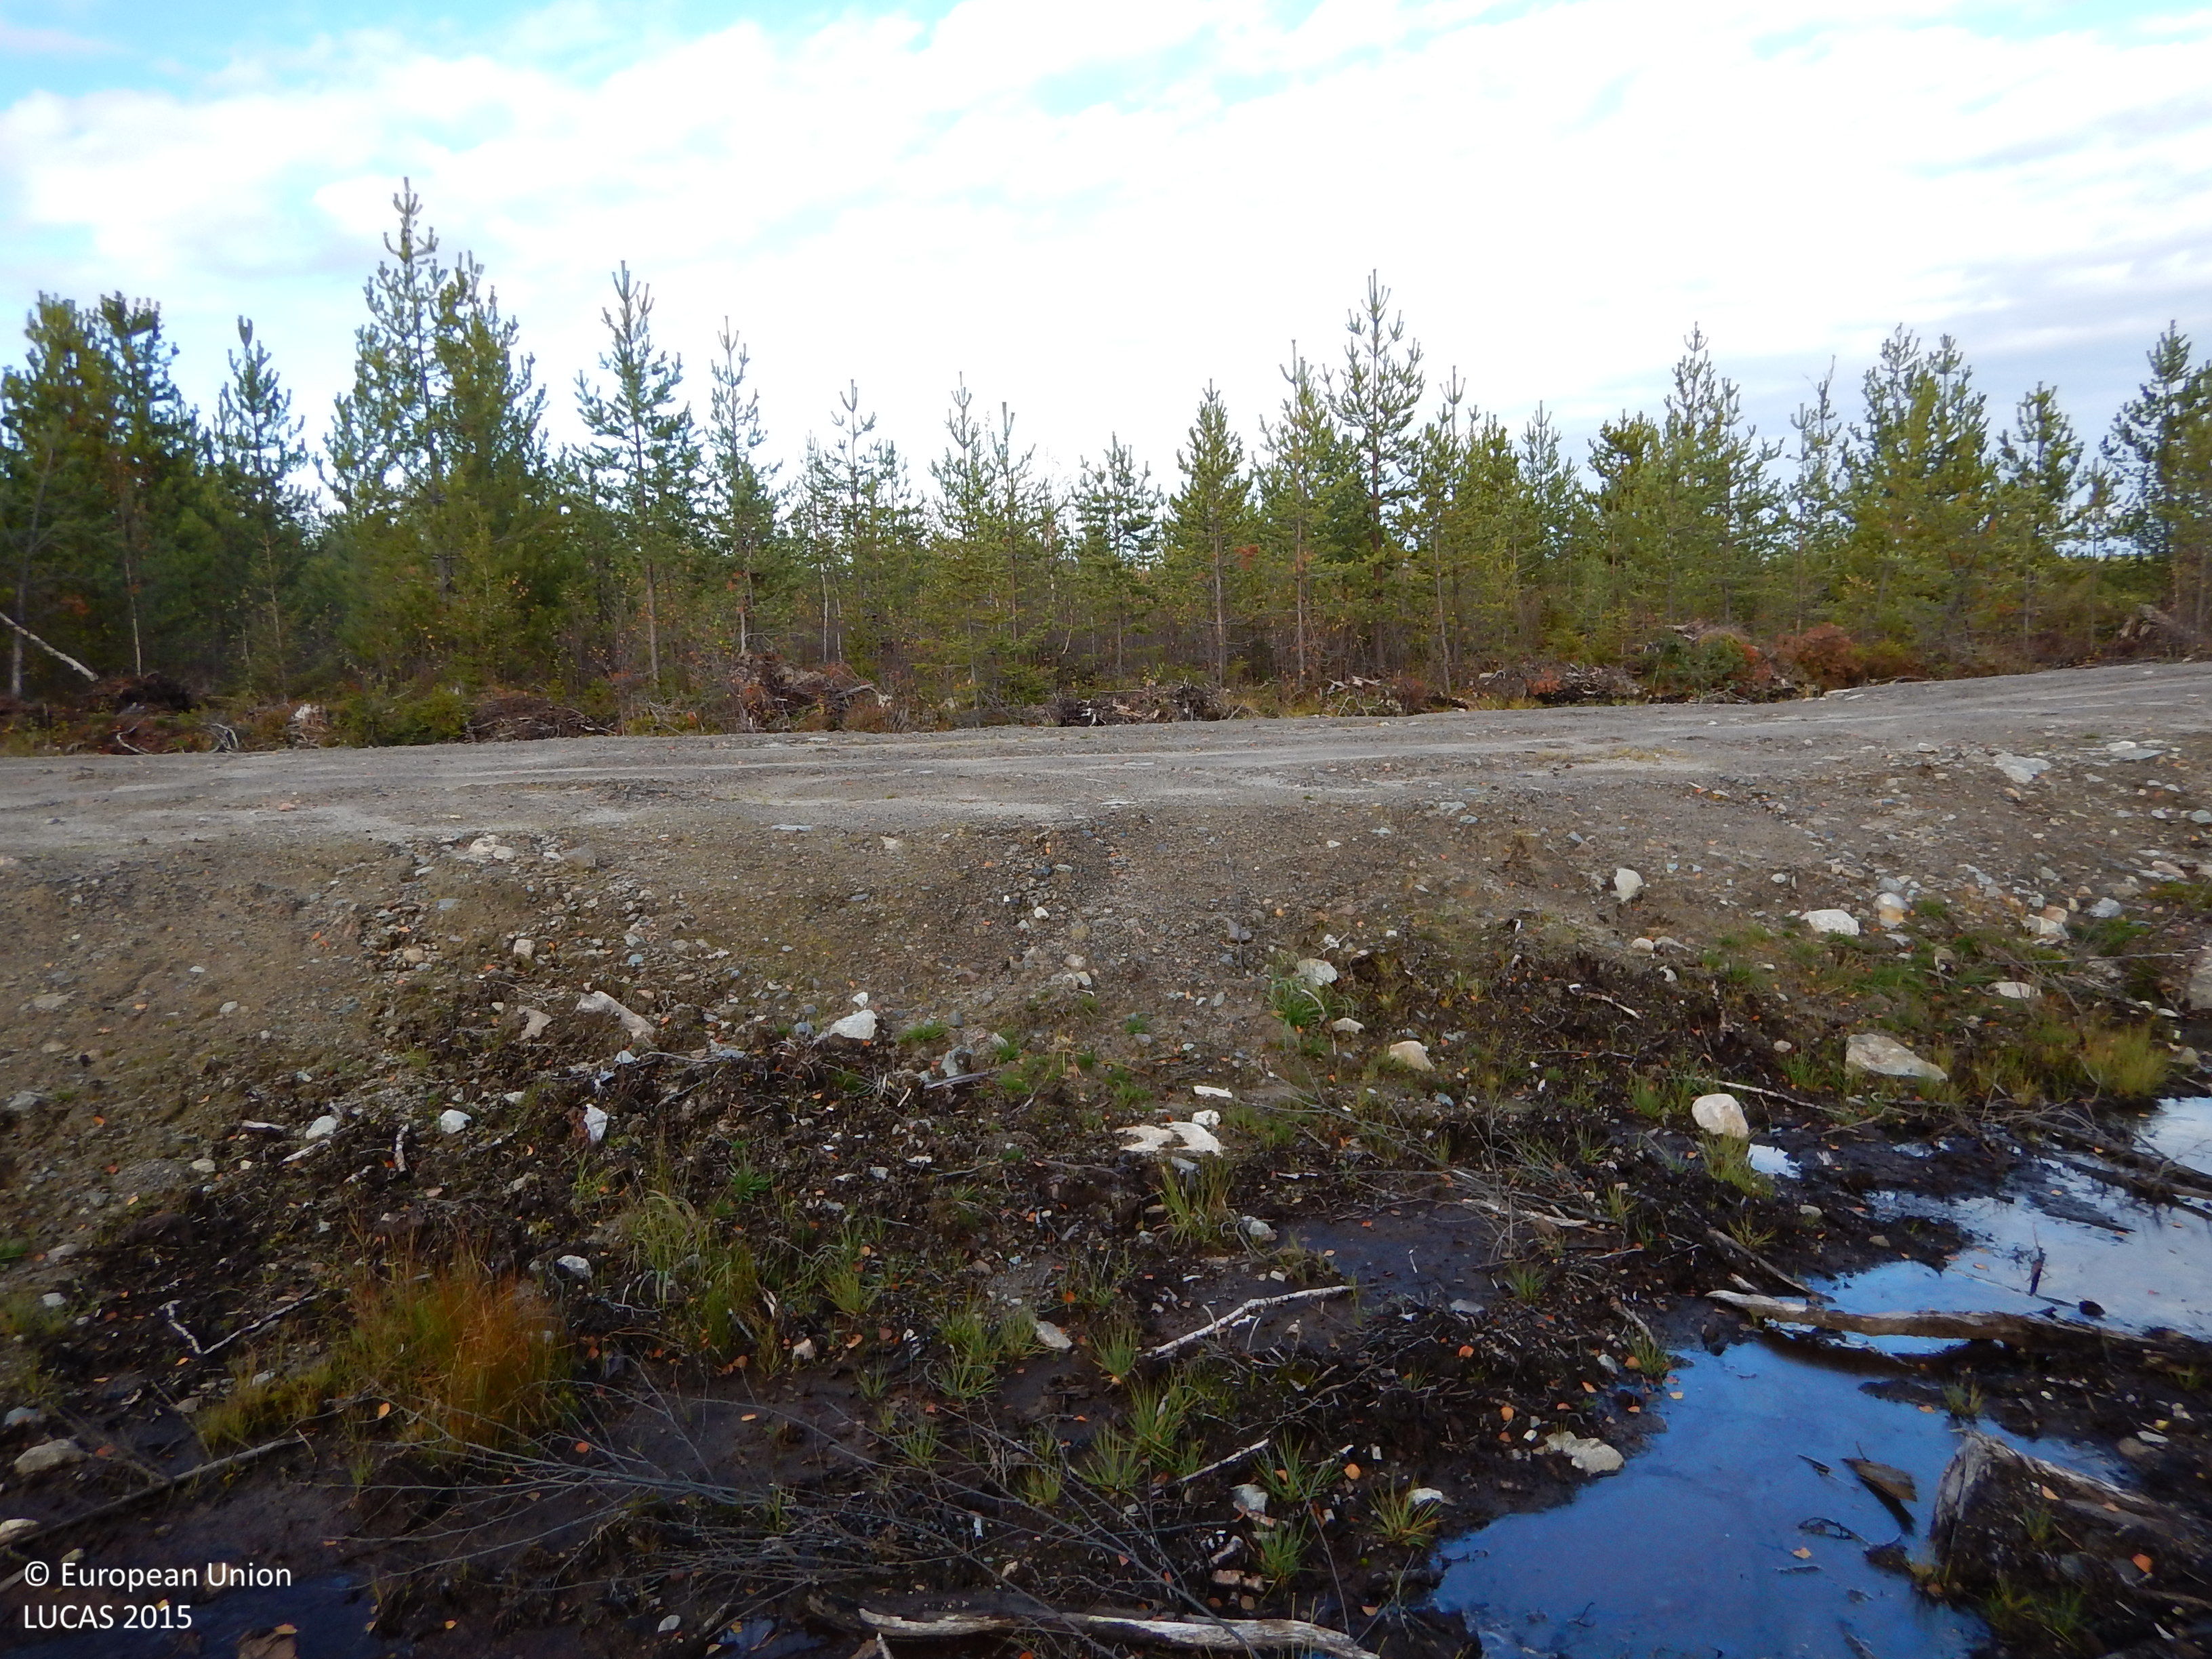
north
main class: Woodland
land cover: Other mixed woodland
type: boreal forest
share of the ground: 50 - 75 %
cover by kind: coniferous forest trees 45 %, broadleaved forest trees 25 %, herbaceous plants 15 %, shrubs 10 %, lichens and mosses 5 %
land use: Forestry
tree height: < 5 m
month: October
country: SE
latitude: 64.9822
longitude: 21.0174
